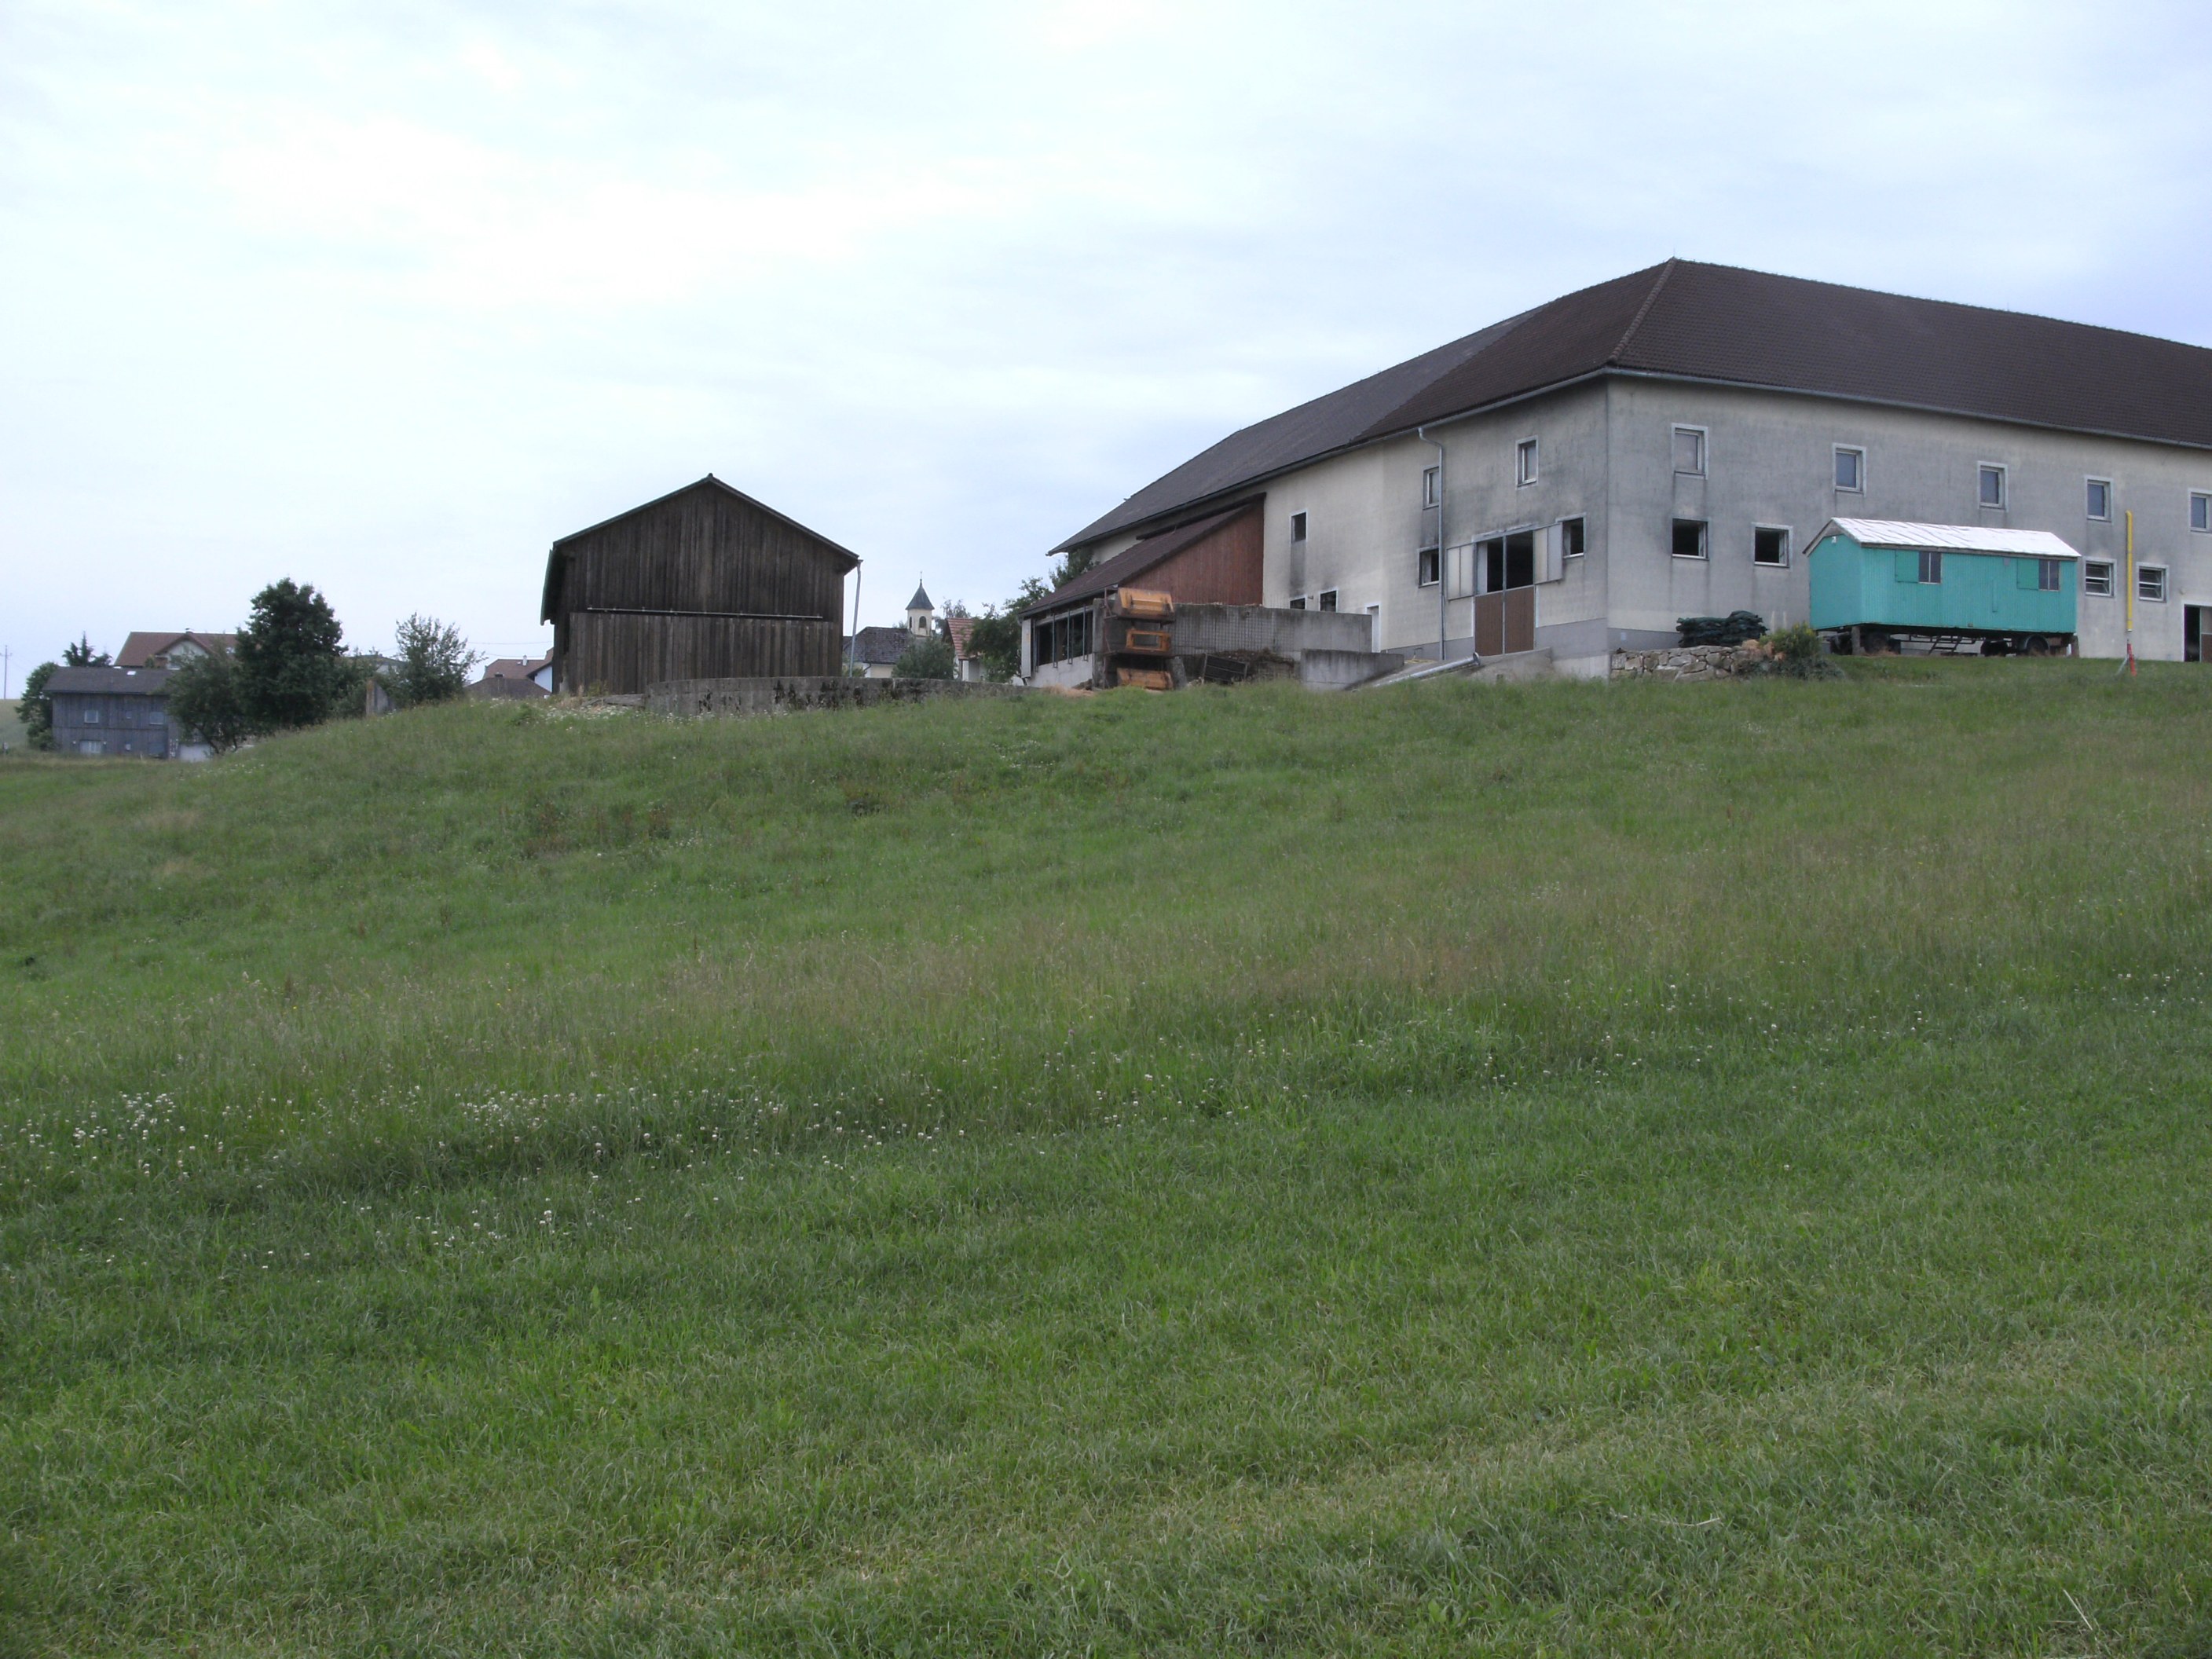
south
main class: Grassland
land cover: Grassland without tree/shrub cover
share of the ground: > 75 %
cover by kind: herbaceous plants 100 %
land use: Agriculture (excluding fallow land and kitchen gardens)
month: June
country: AT
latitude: 48.4737
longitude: 14.0445
